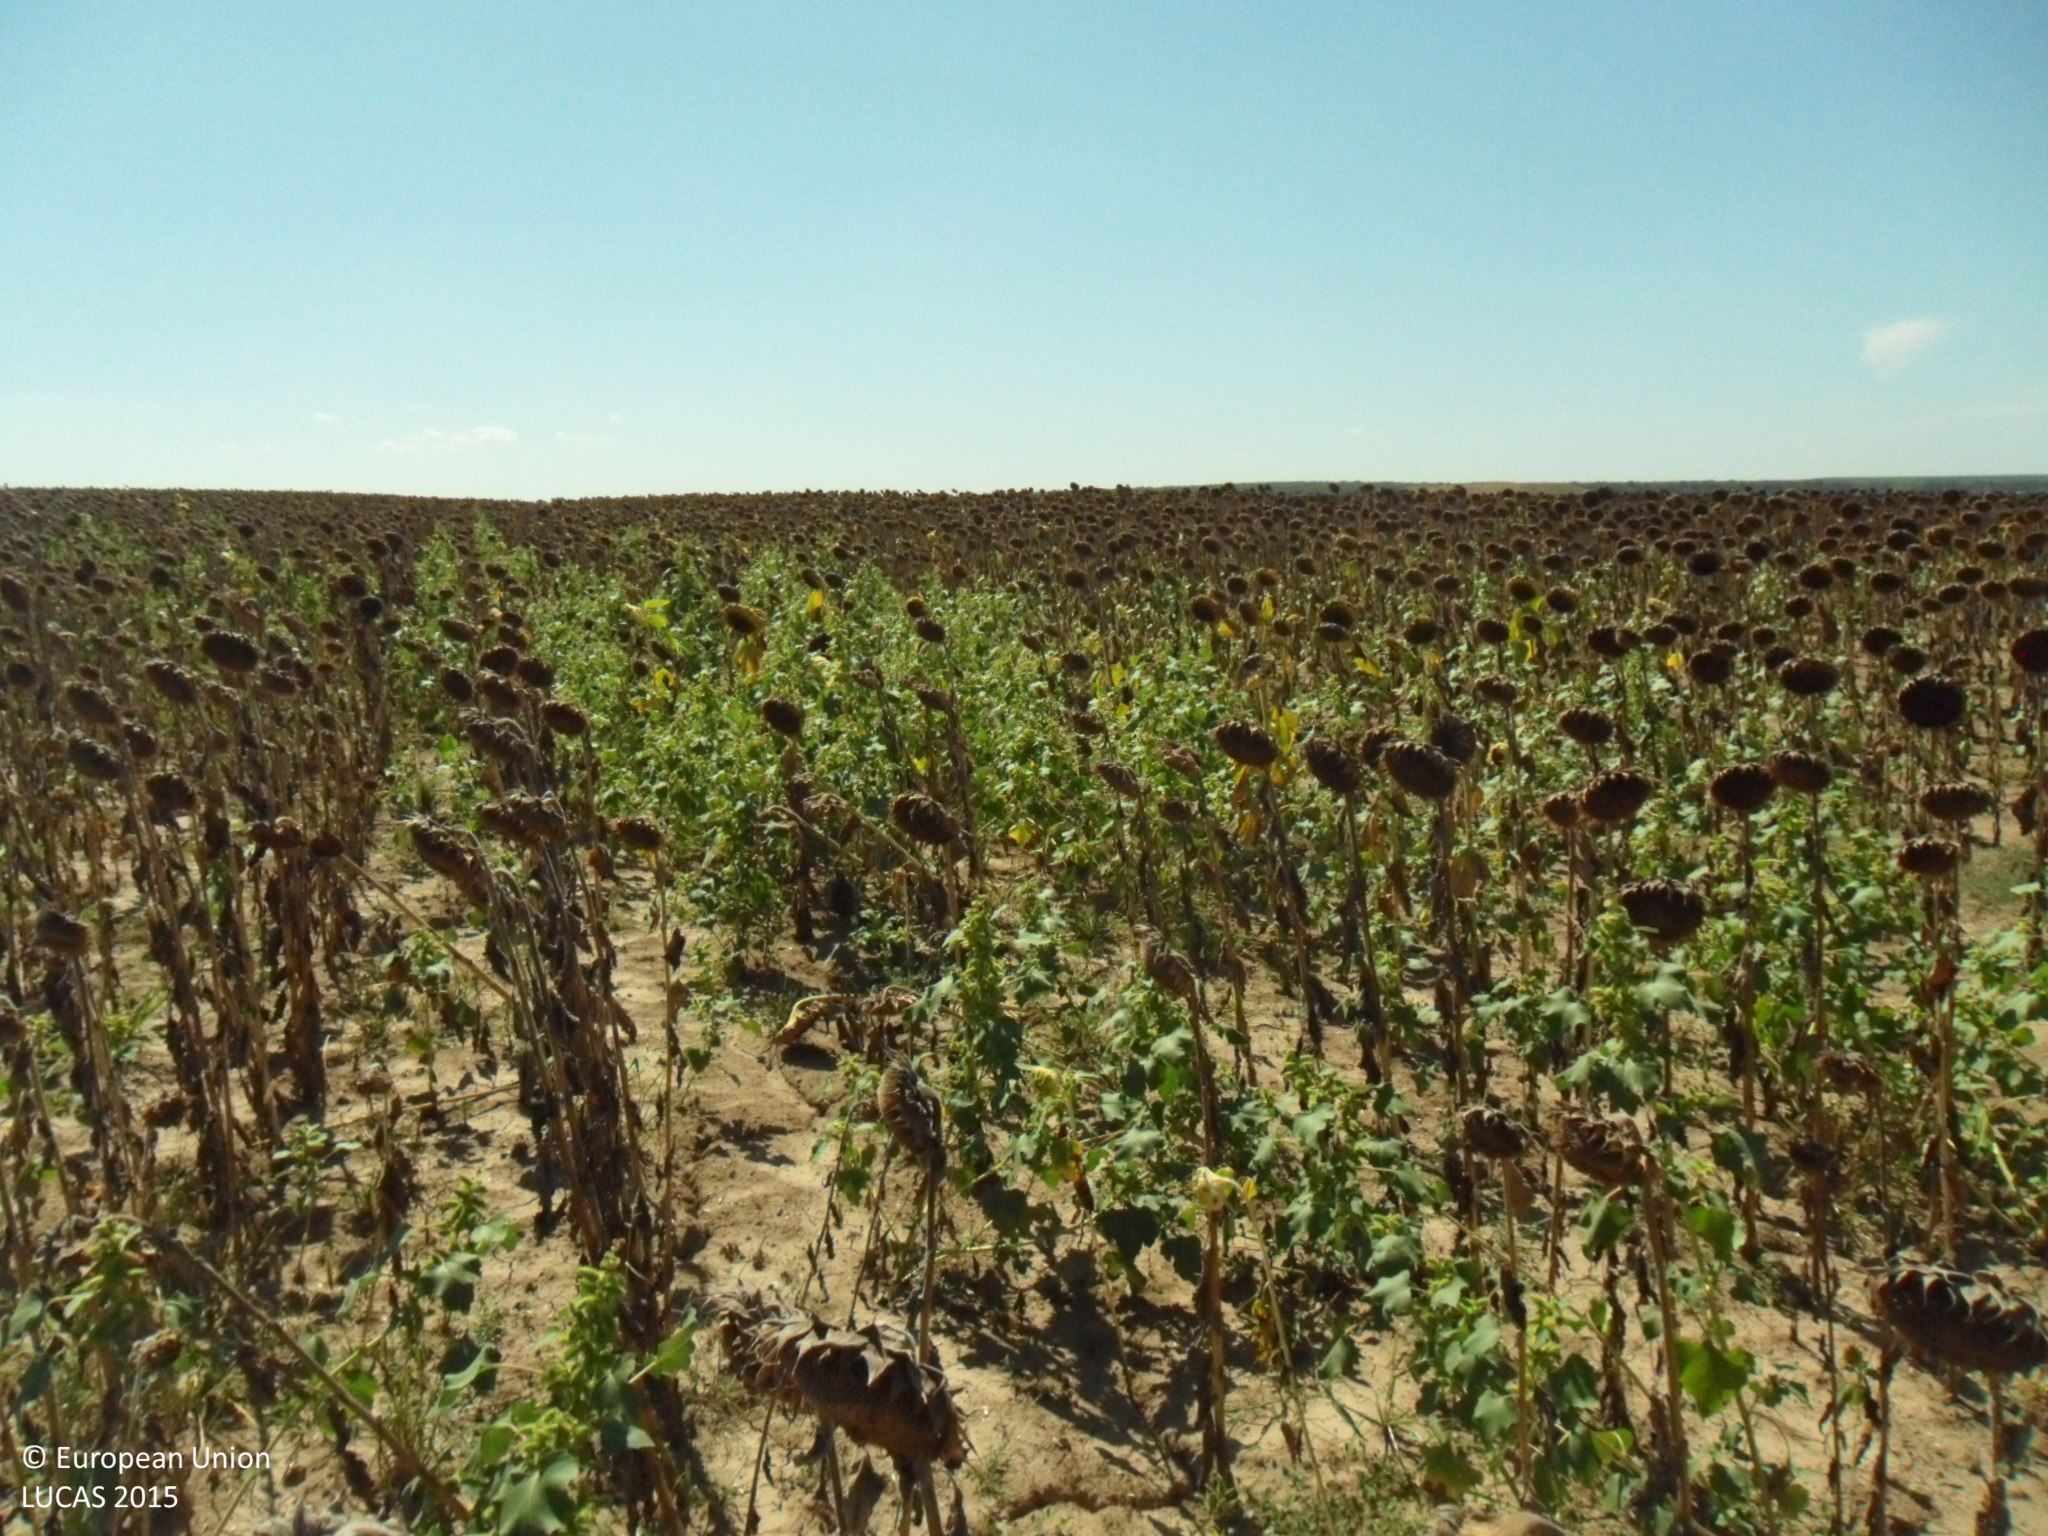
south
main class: Cropland
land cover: Sunflower
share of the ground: 50 - 75 %
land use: Agriculture (excluding fallow land and kitchen gardens)
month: September
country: BG
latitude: 43.6037
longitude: 27.1828
